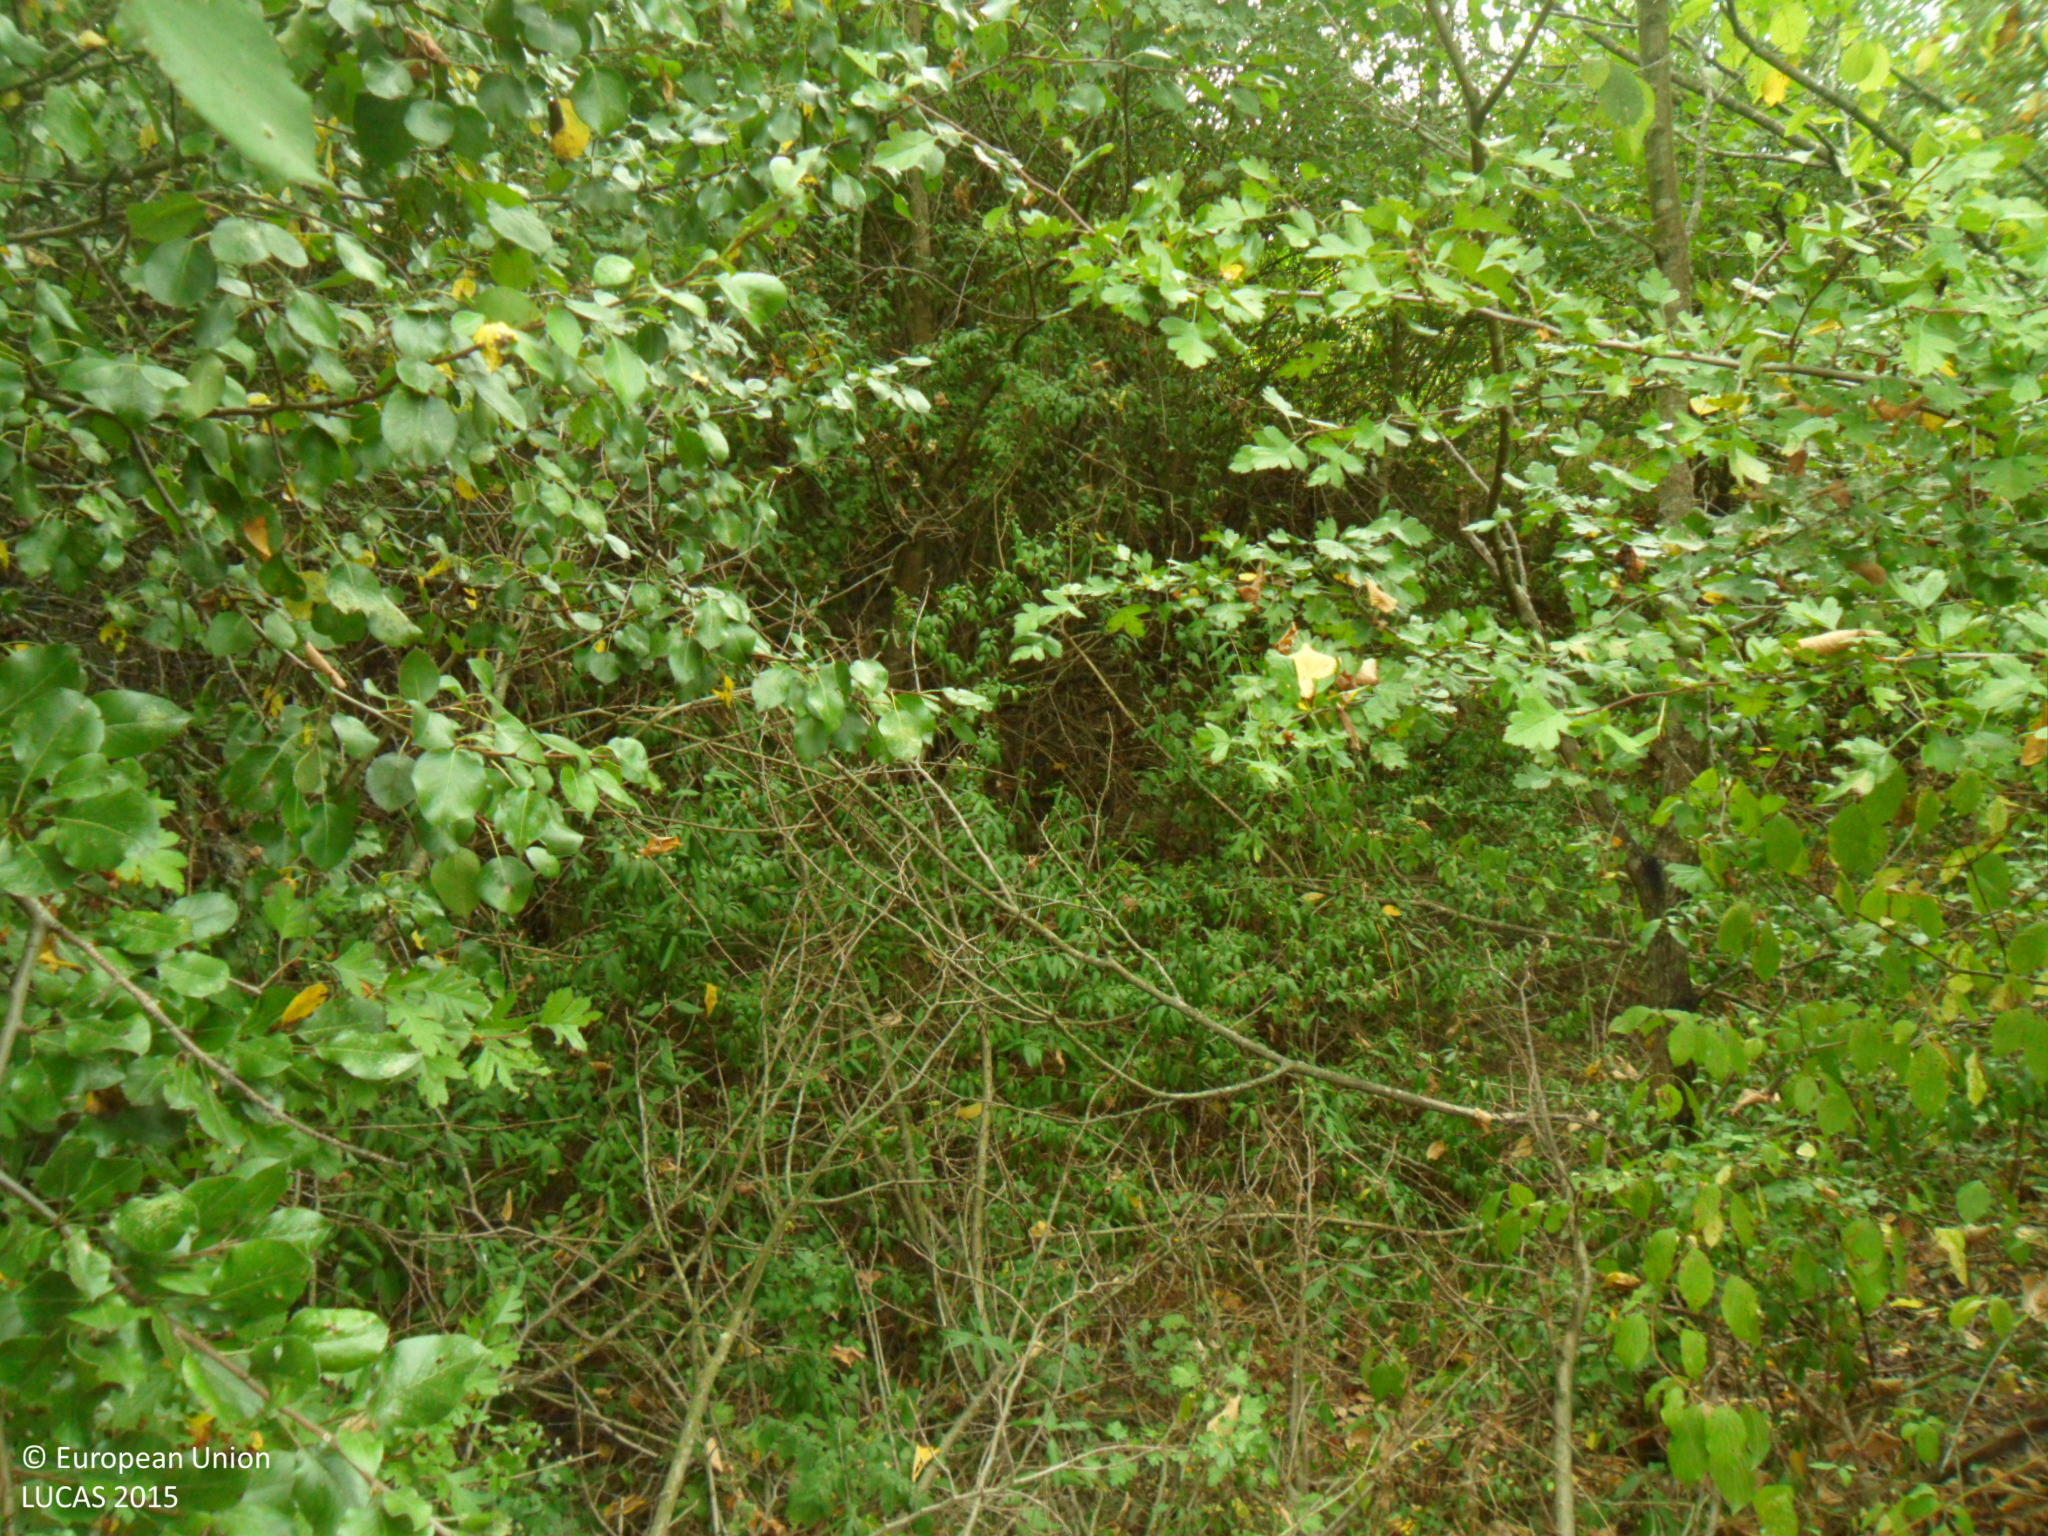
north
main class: Shrubland
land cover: Shrubland with sparse tree cover
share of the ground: > 75 %
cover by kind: shrubs 95 %, broadleaved forest trees 5 %
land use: Semi-natural and natural areas not in use
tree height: > 5 m
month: August
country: BG
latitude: 43.0563
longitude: 26.7167
